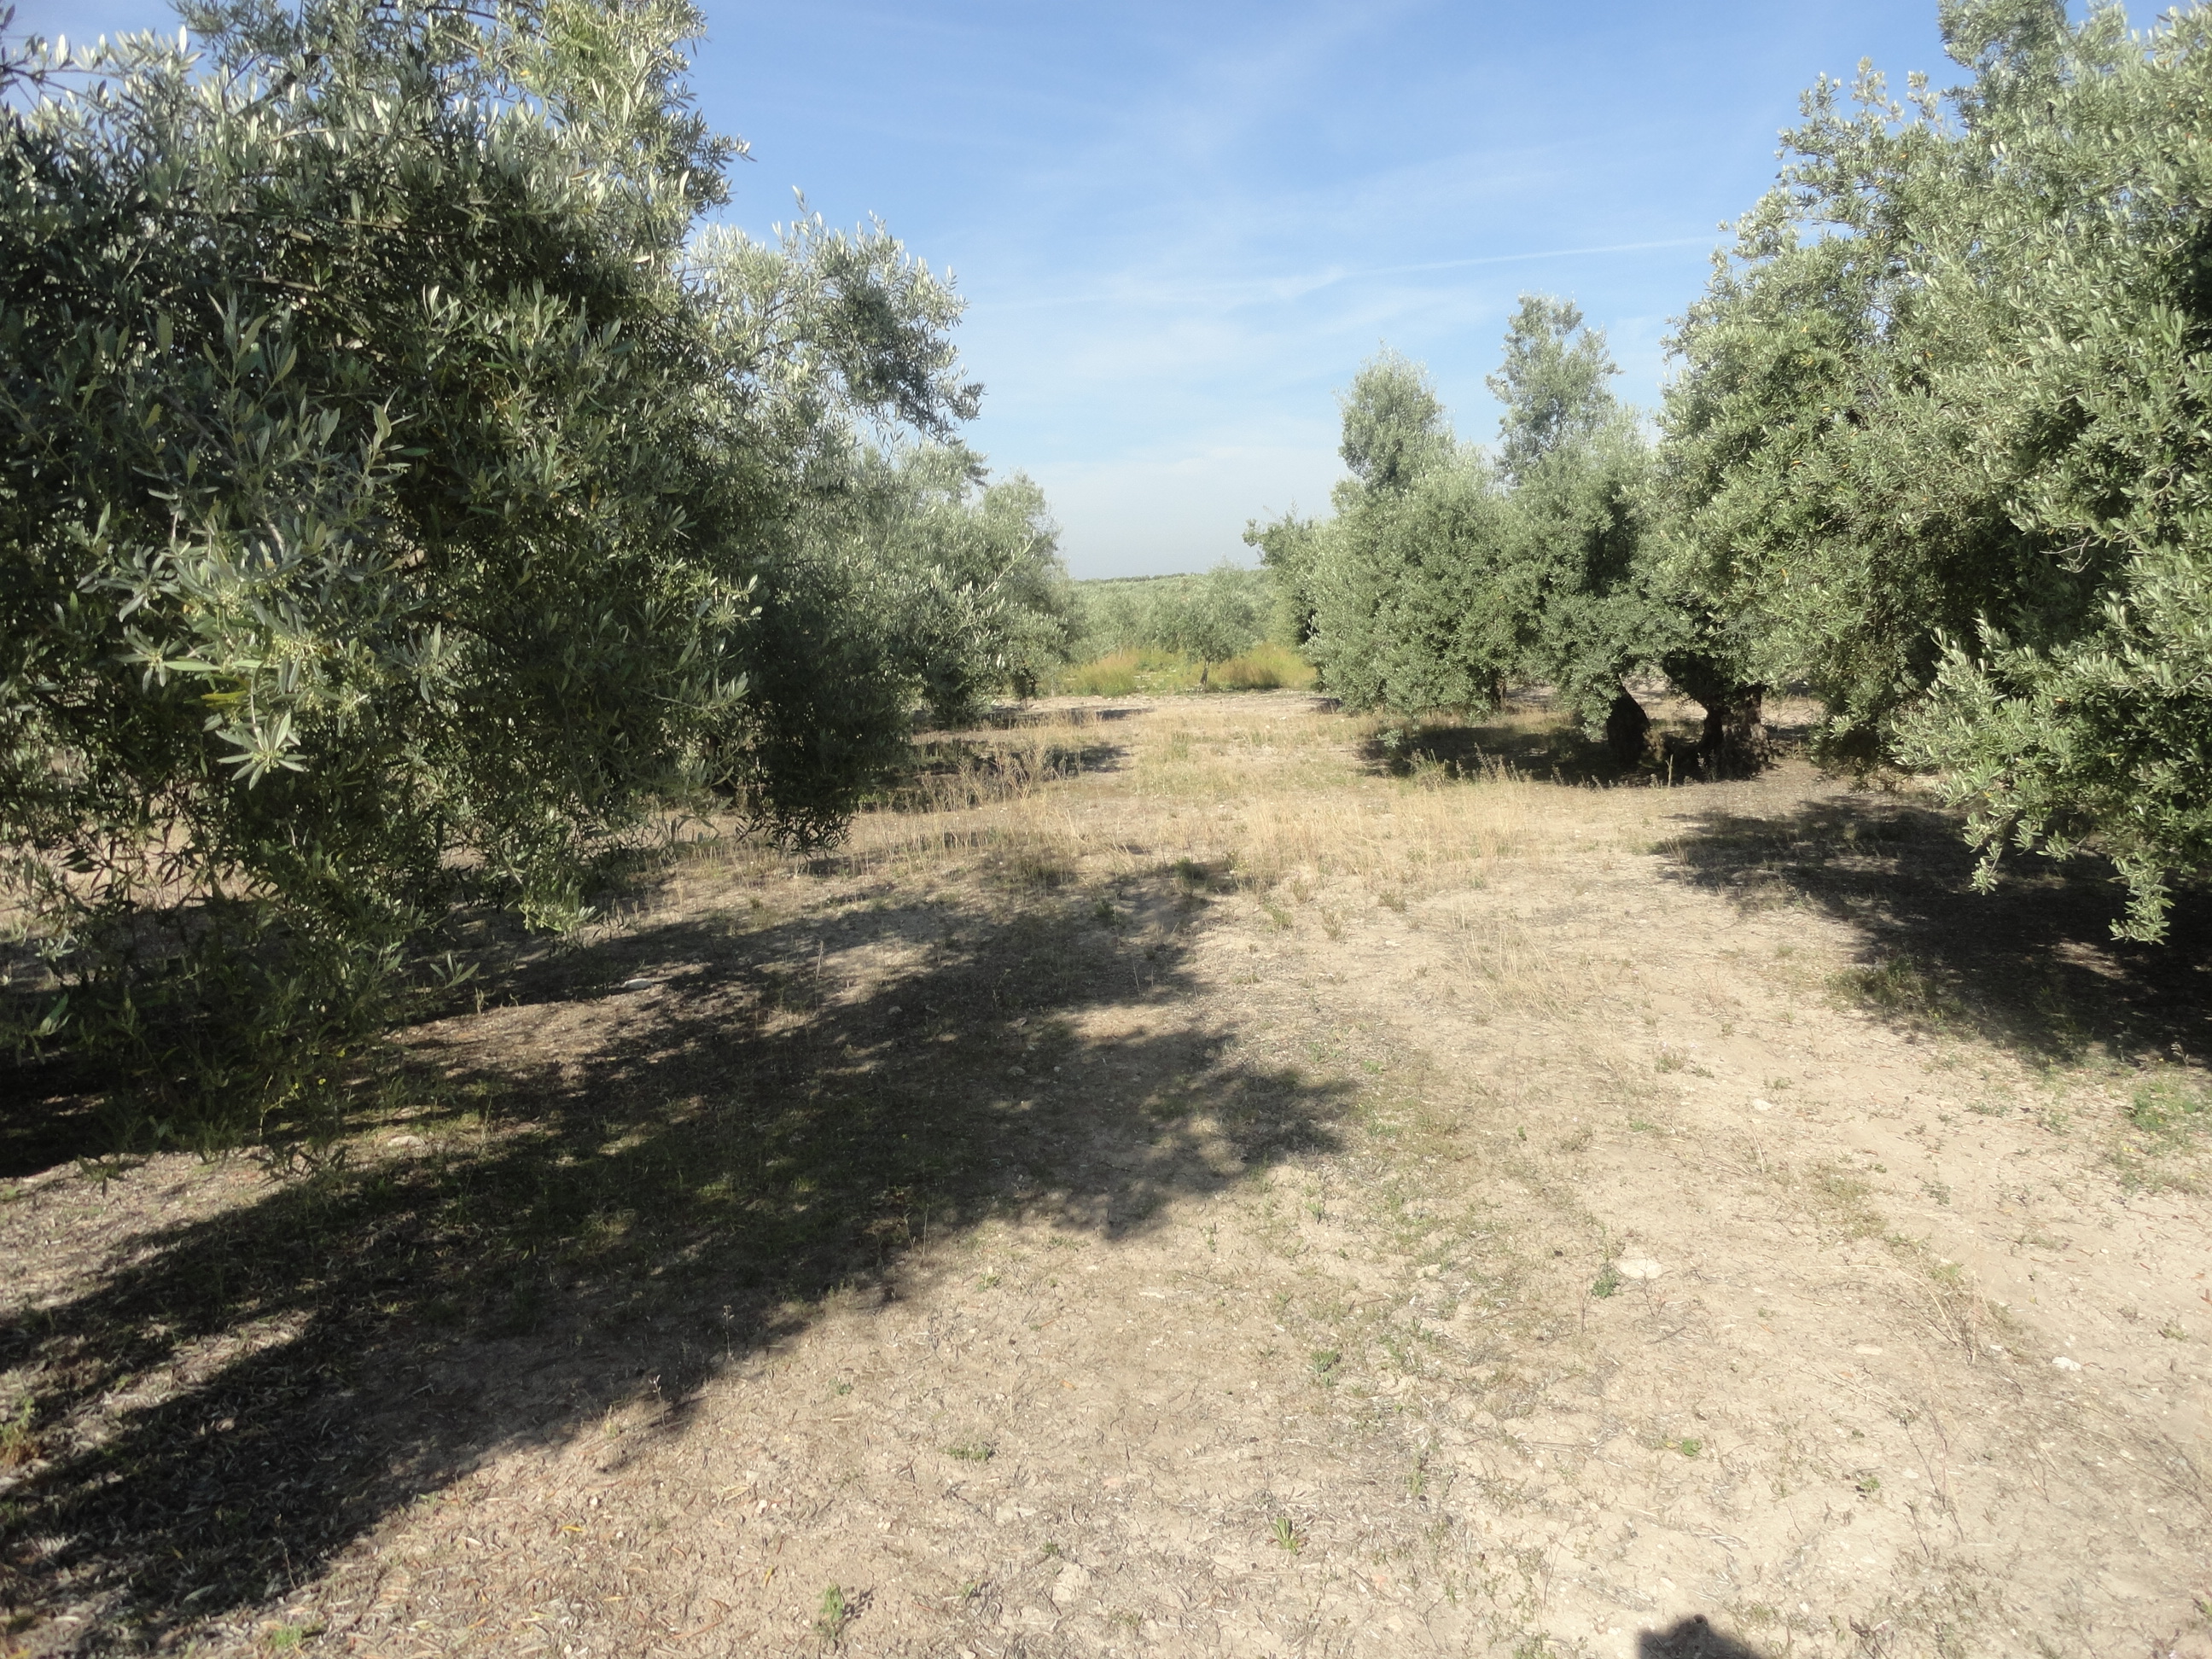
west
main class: Cropland
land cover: Olive groves
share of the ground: 50 - 75 %
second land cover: Spontaneously vegetated surfaces
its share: 25 - 50 %
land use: Agriculture (excluding fallow land and kitchen gardens)
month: April
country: ES
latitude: 37.6408
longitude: -4.5014
